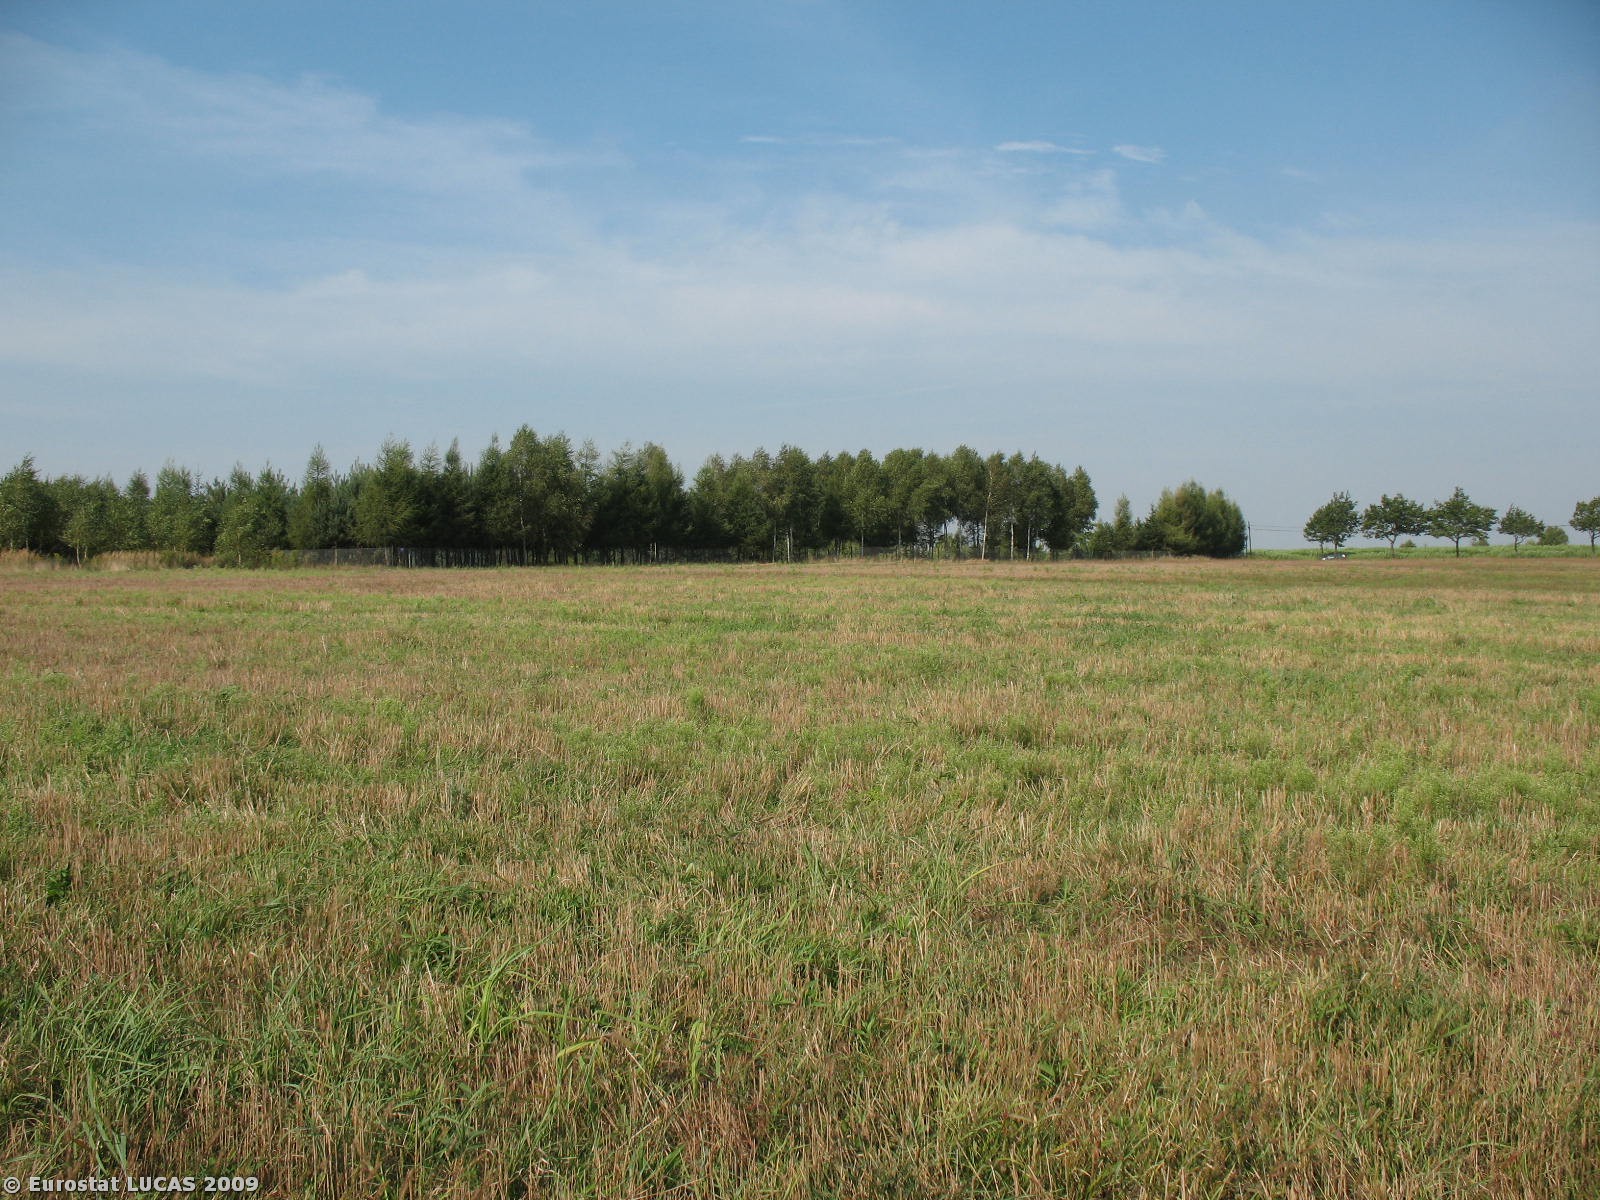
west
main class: Cropland
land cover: Mixed cereals for fodder
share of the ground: < 10 %
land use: Agriculture (excluding fallow land and kitchen gardens)
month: September
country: PL
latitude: 50.2428
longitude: 22.1327
